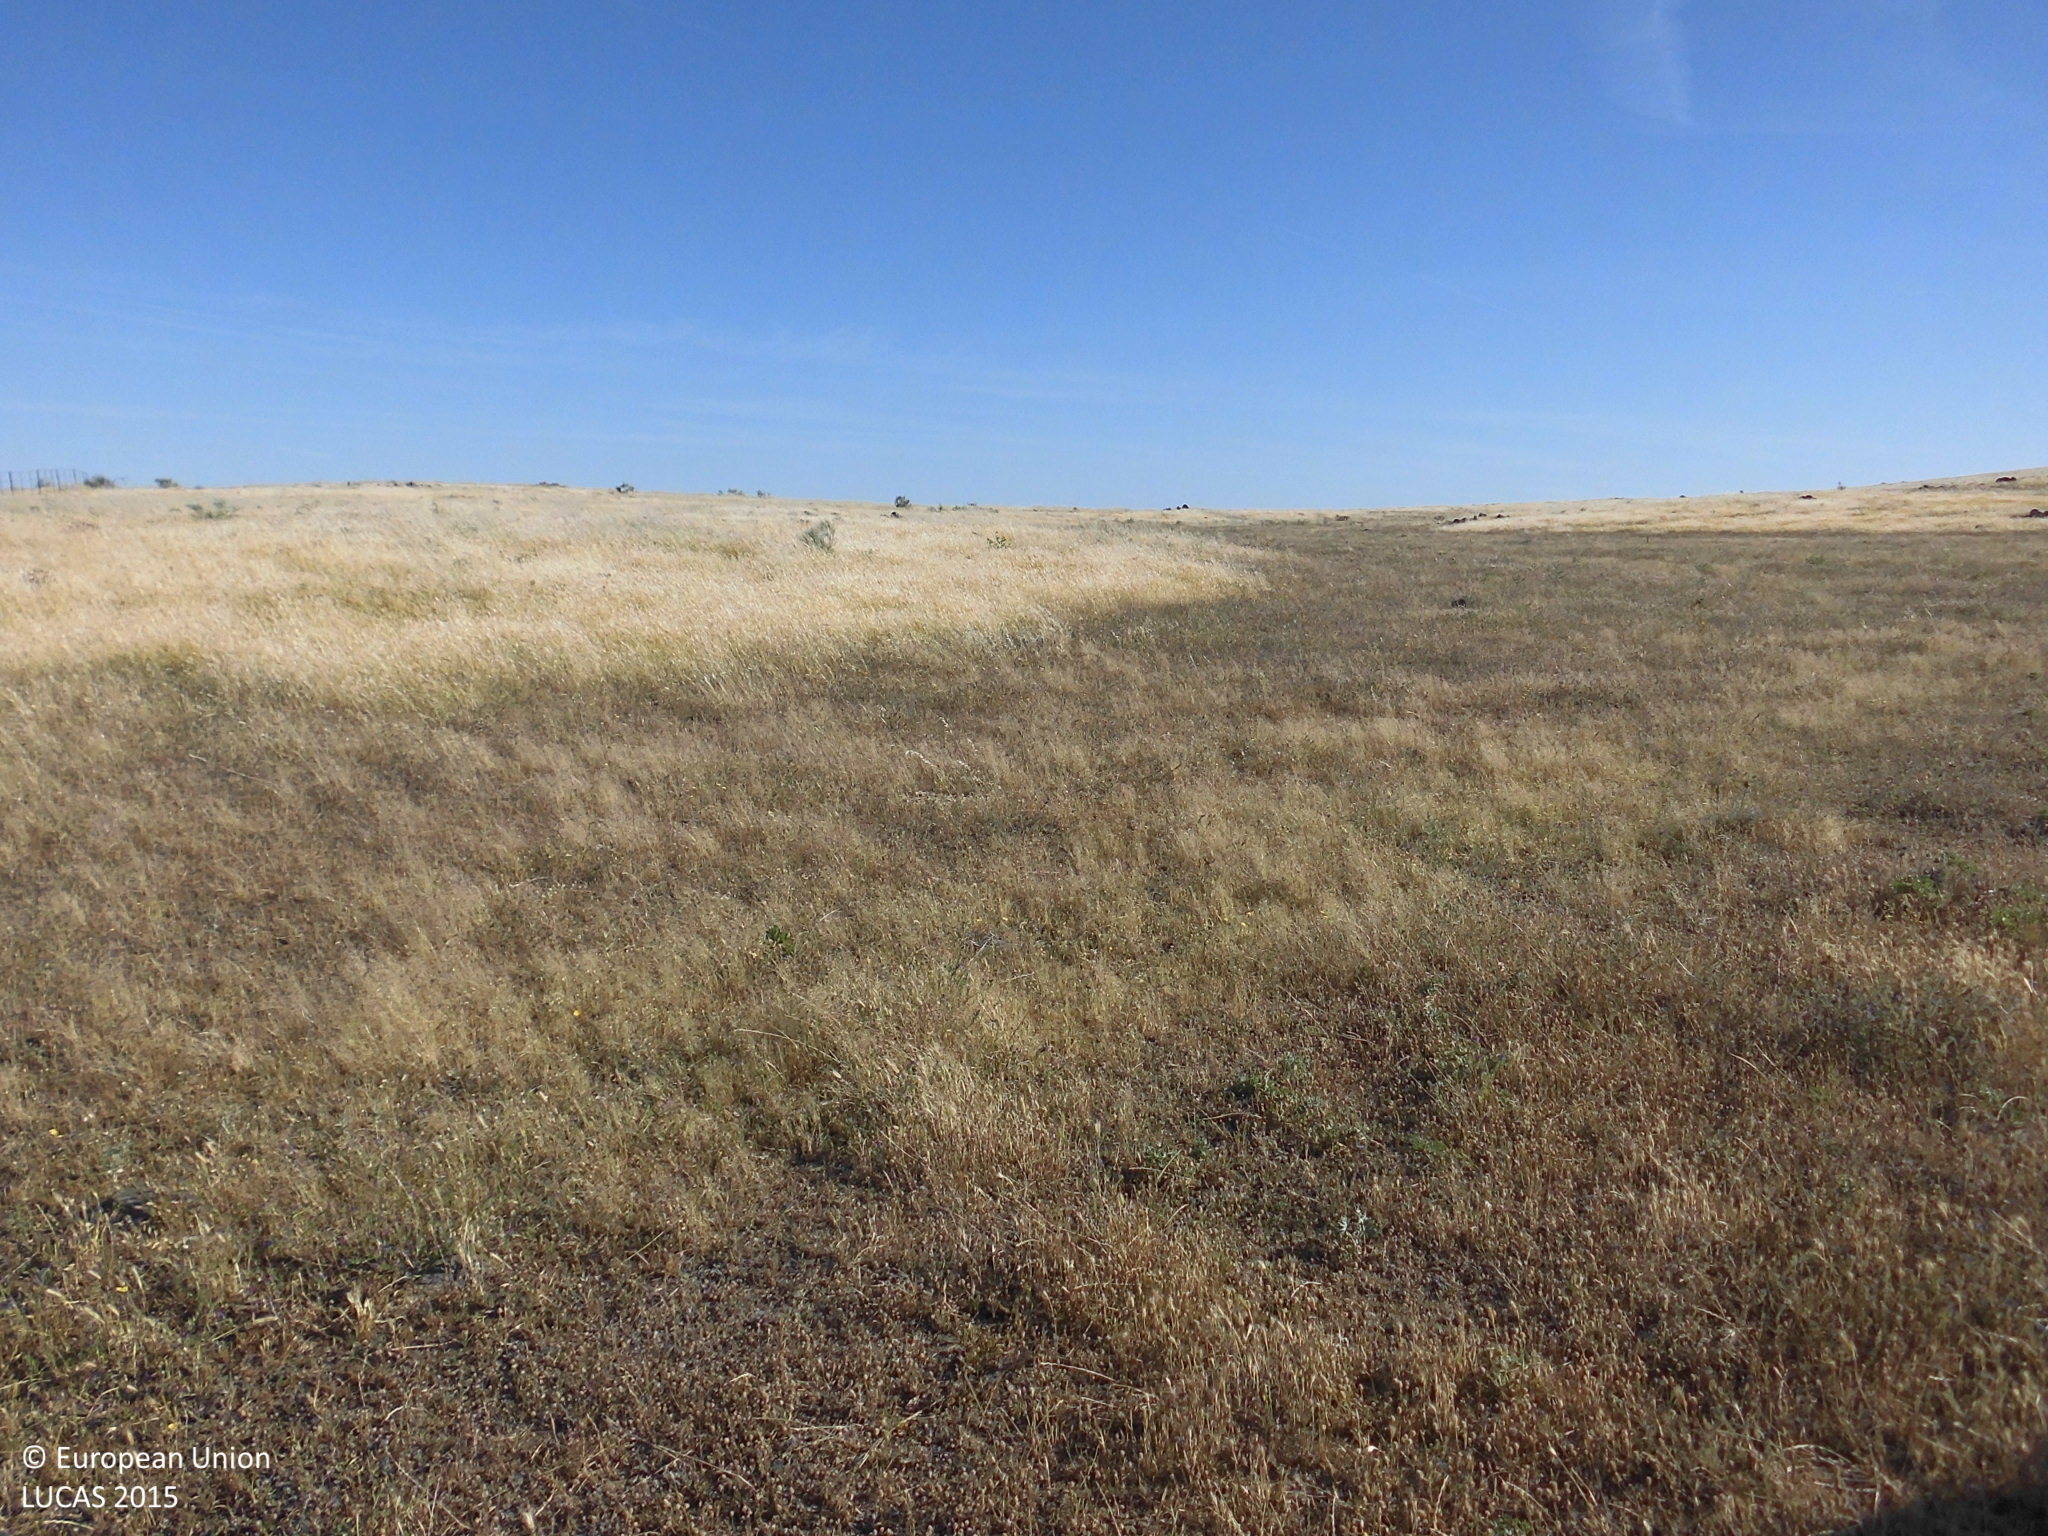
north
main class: Woodland
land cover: Broadleaved woodland
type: broadleaved evergreen forest
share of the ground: 10 - 25 %
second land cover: Grassland without tree/shrub cover
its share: > 75 %
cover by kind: herbaceous plants 85 %, broadleaved forest trees 15 %
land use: Forestry
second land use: Agriculture (excluding fallow land and kitchen gardens)
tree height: > 5 m
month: May
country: ES
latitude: 39.4659
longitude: -6.8265
